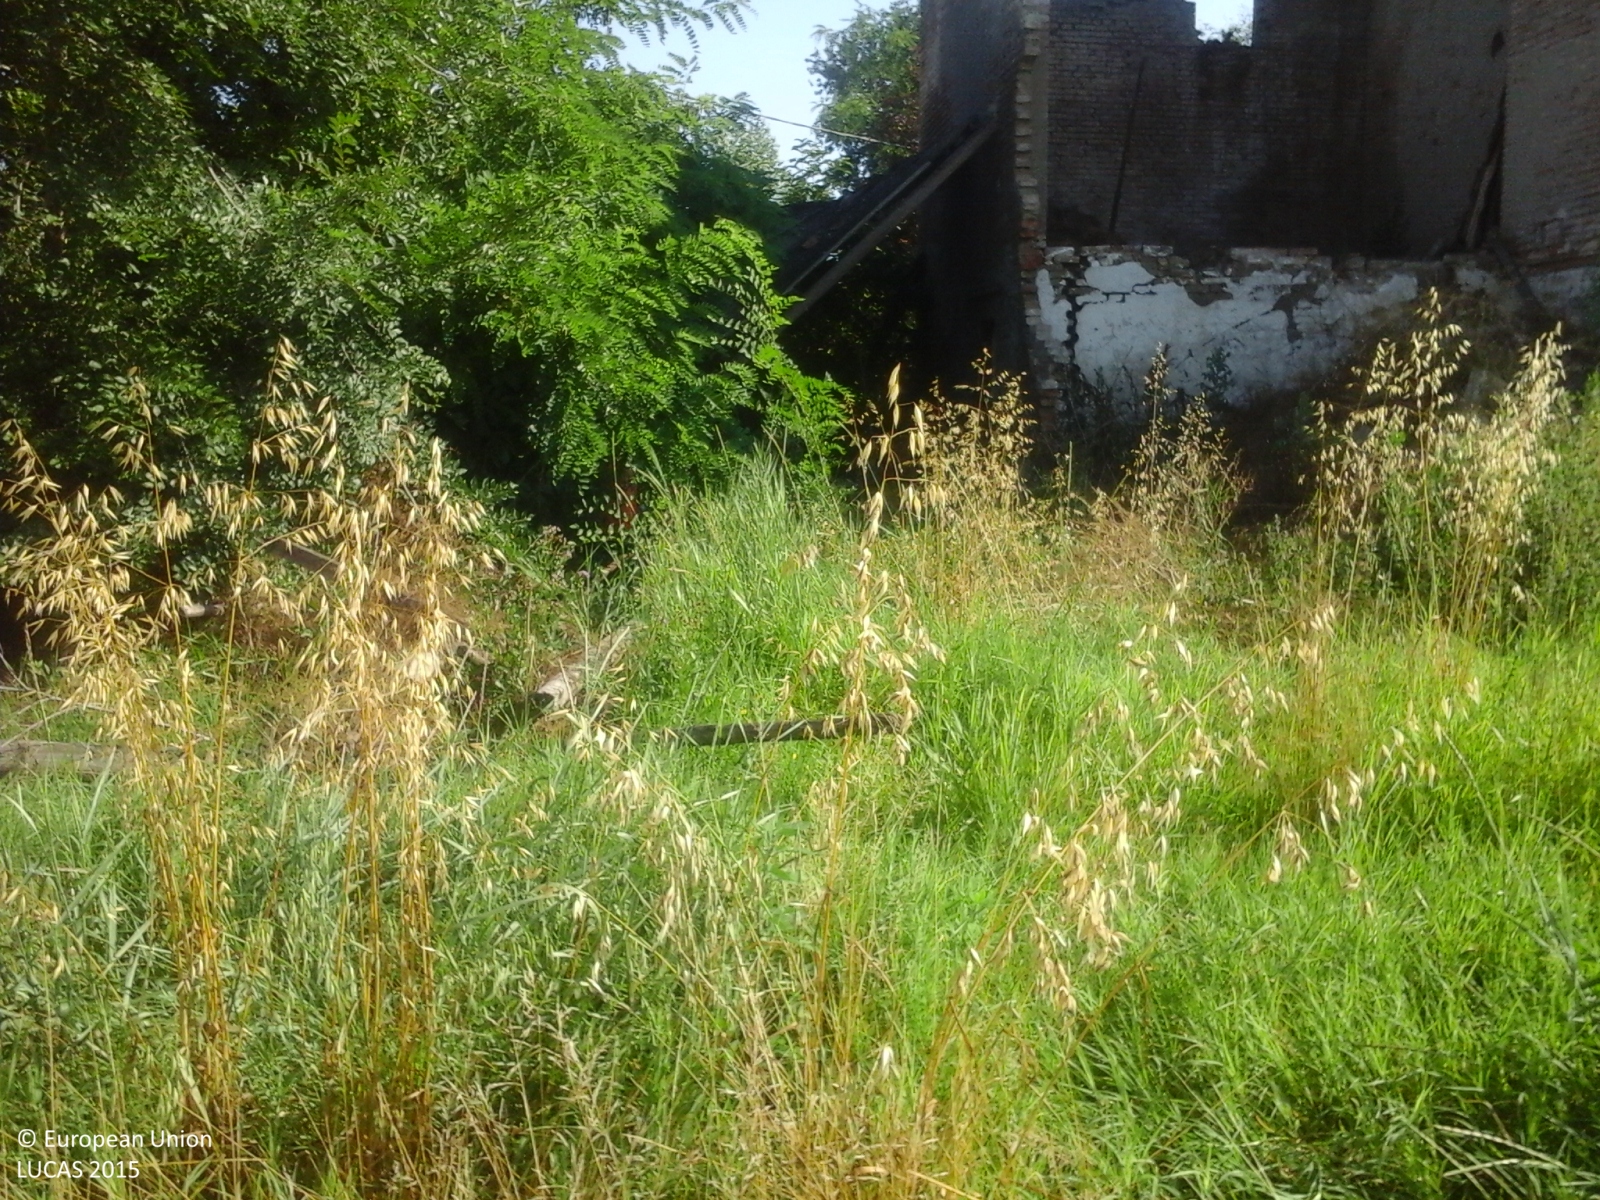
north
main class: Cropland
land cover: Common wheat
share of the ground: > 75 %
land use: Agriculture (excluding fallow land and kitchen gardens)
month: June
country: IT
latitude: 44.8875
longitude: 10.9224
